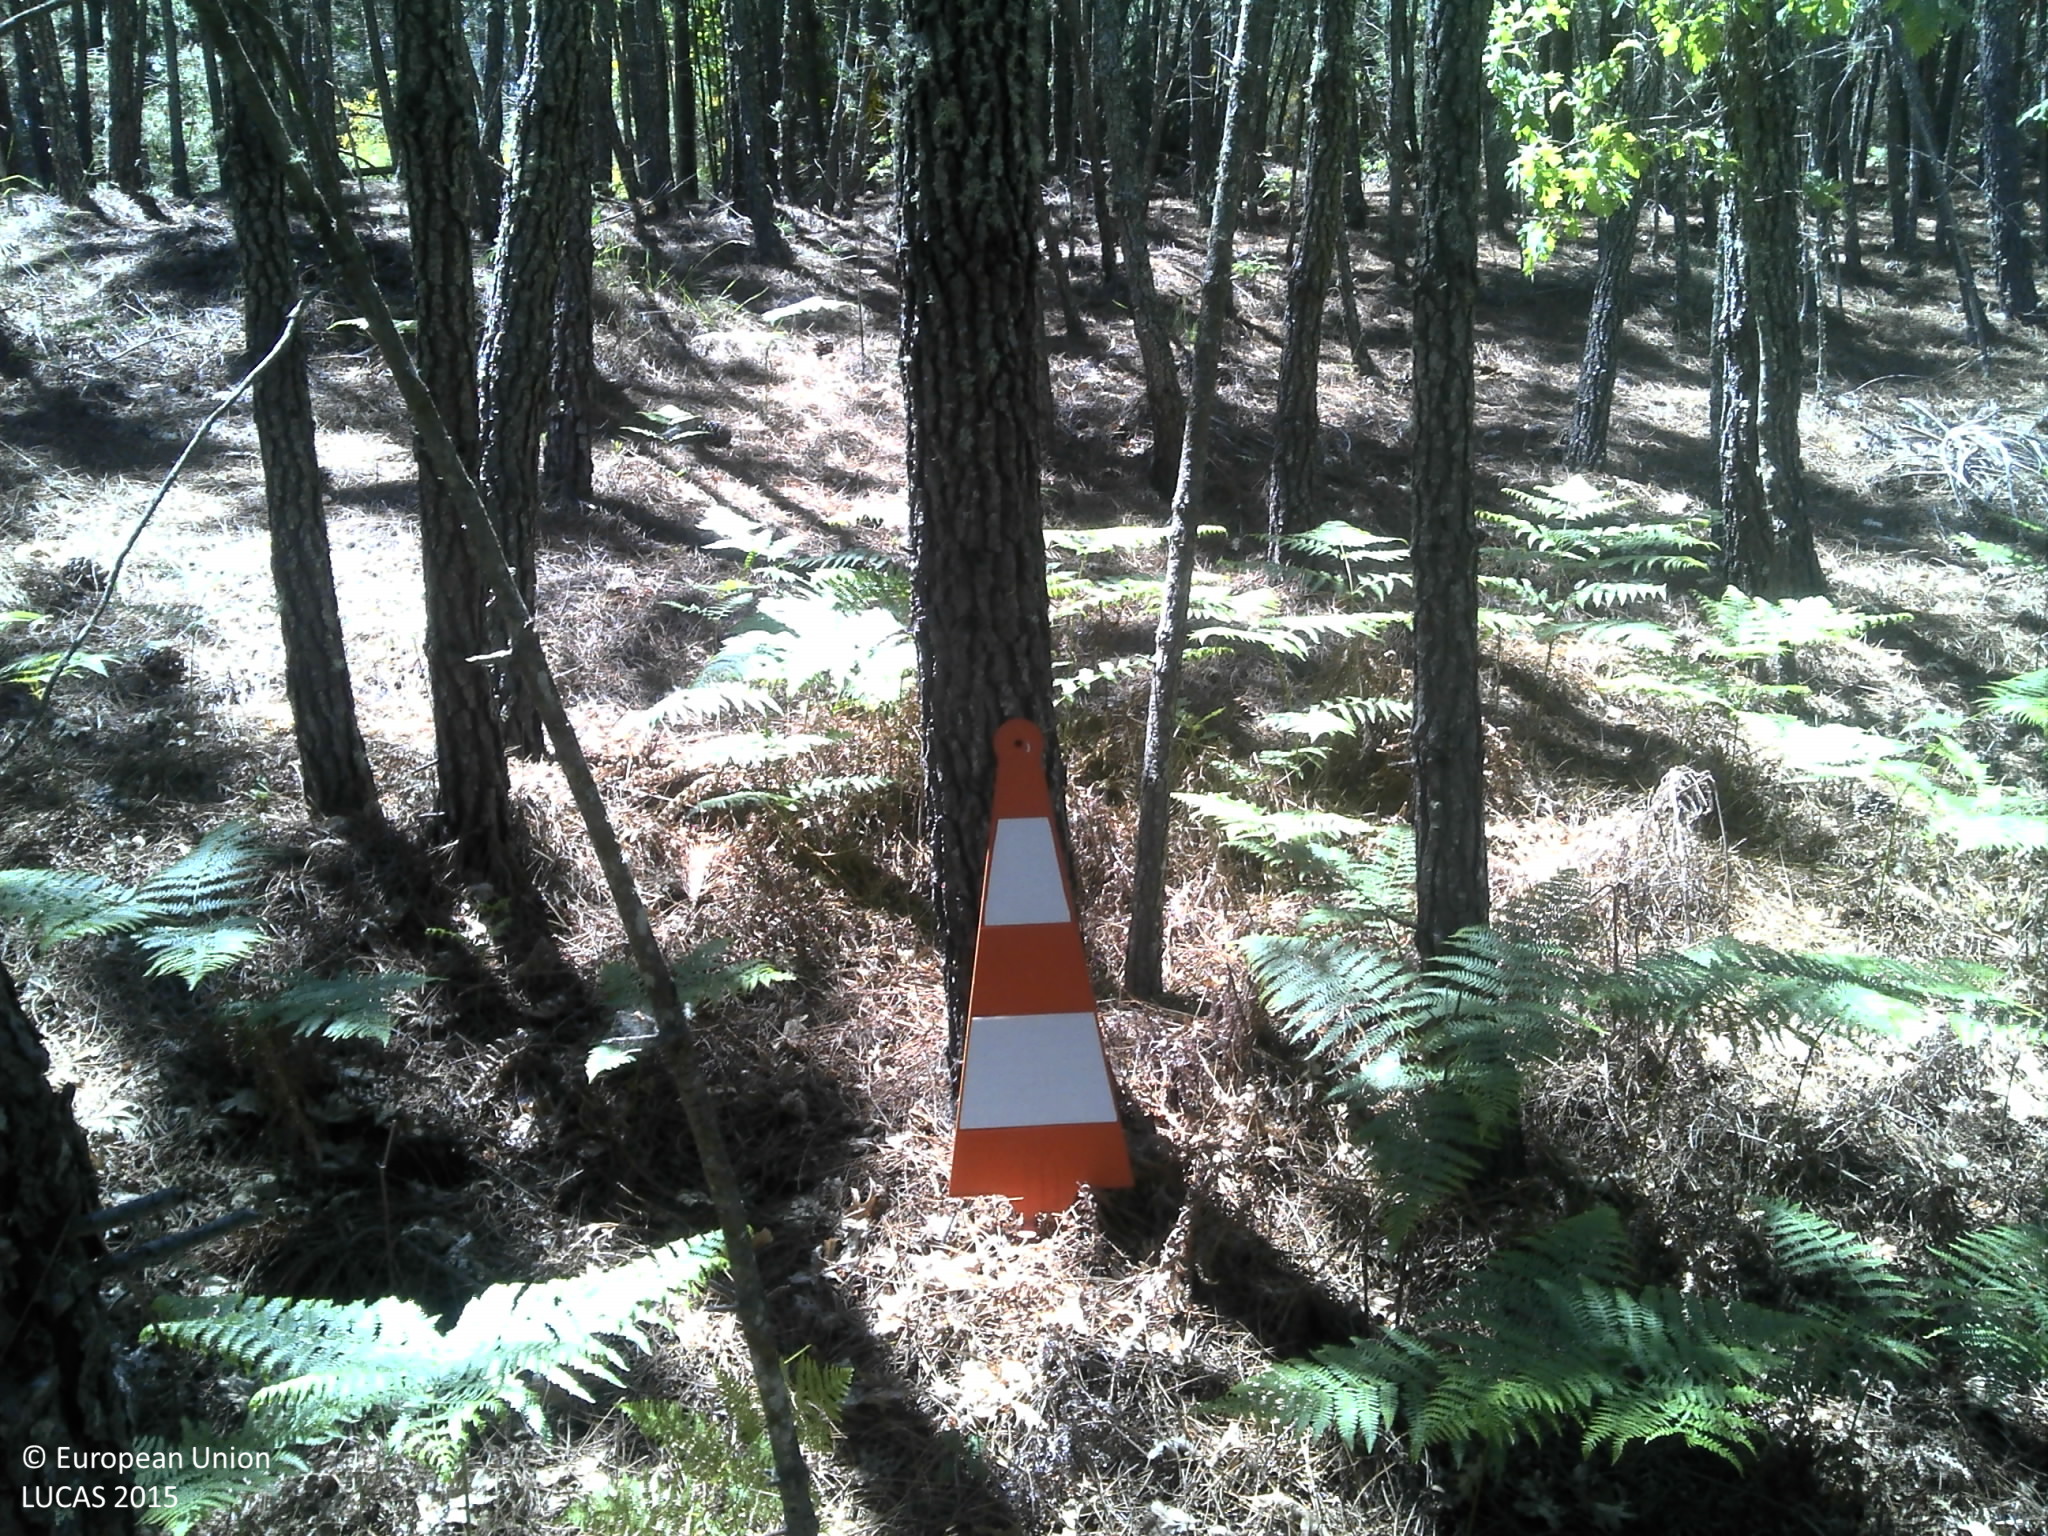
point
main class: Woodland
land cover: Pine dominated coniferous woodland
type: coniferous forest of the mediterranean region
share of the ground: 50 - 75 %
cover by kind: coniferous forest trees 75 %, unconsolidated bare surface 20 %, herbaceous plants 5 %
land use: Forestry
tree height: > 5 m
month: May
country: PT
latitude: 40.5014
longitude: -7.2261
